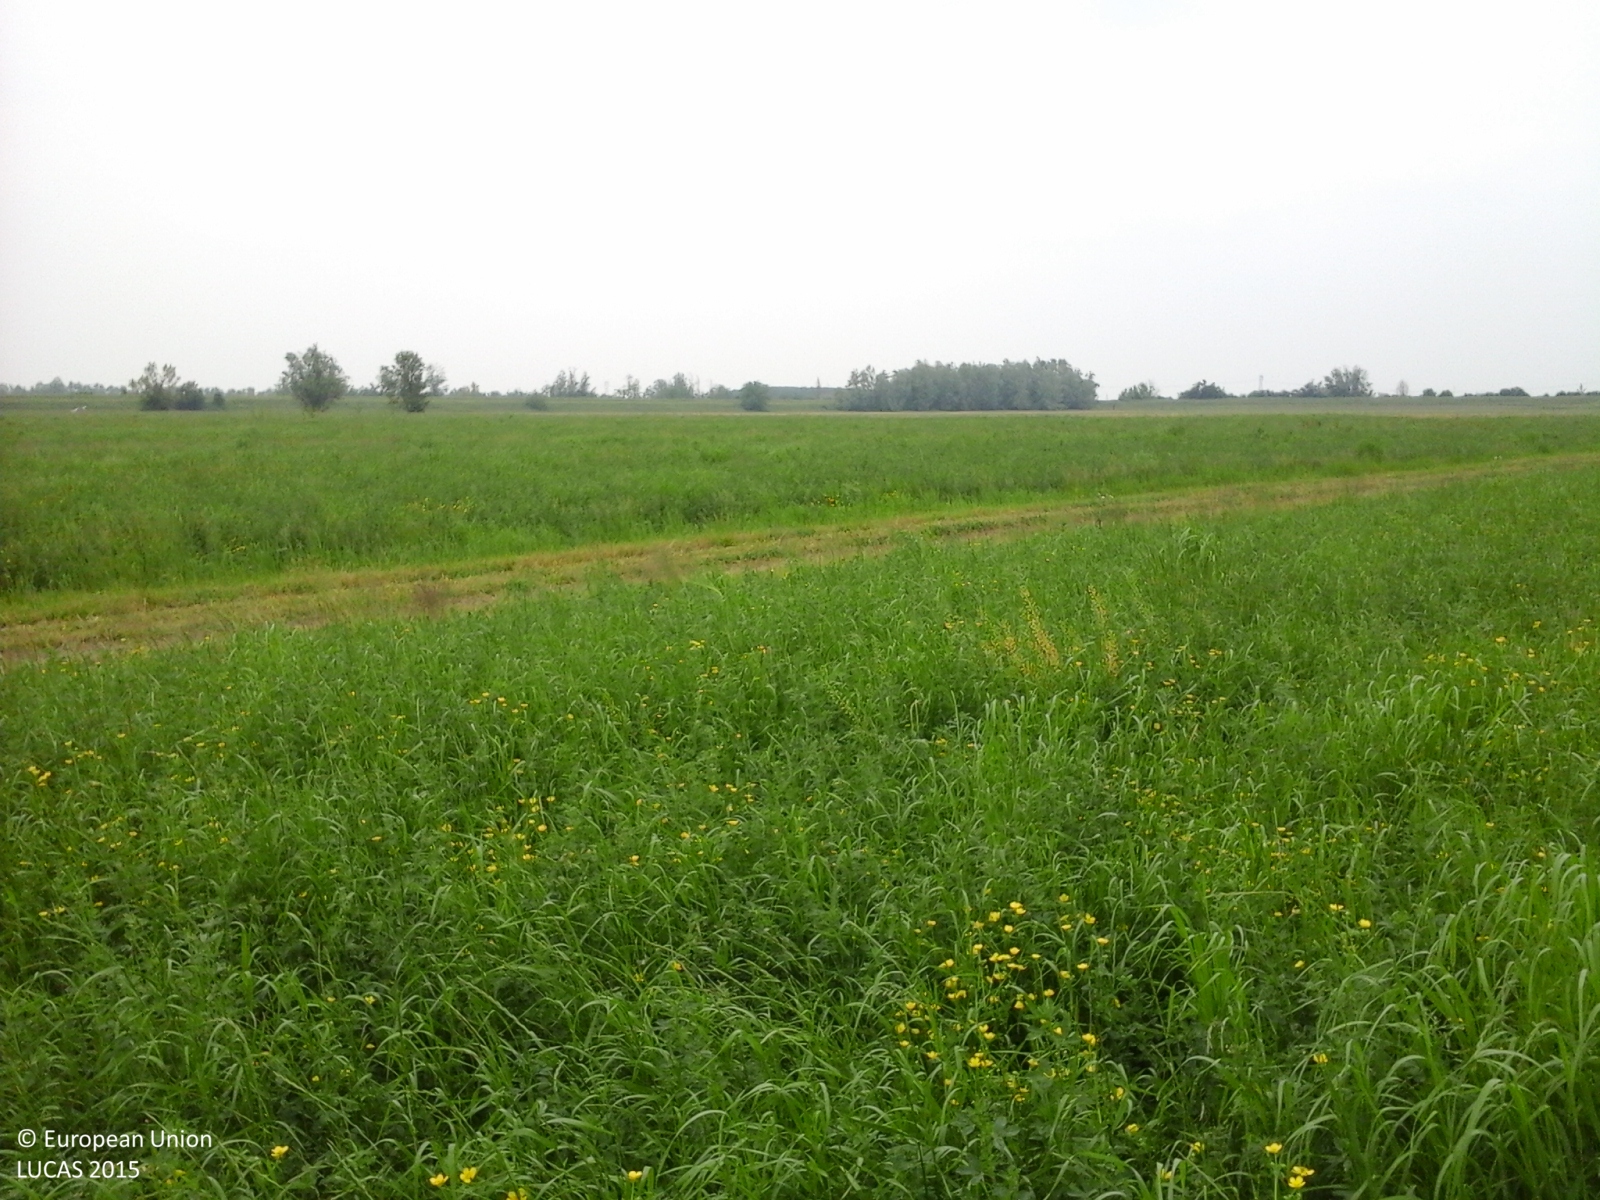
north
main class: Cropland
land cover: Lucerne
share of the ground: > 75 %
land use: Agriculture (excluding fallow land and kitchen gardens)
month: May
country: IT
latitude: 44.8889
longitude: 10.7455
